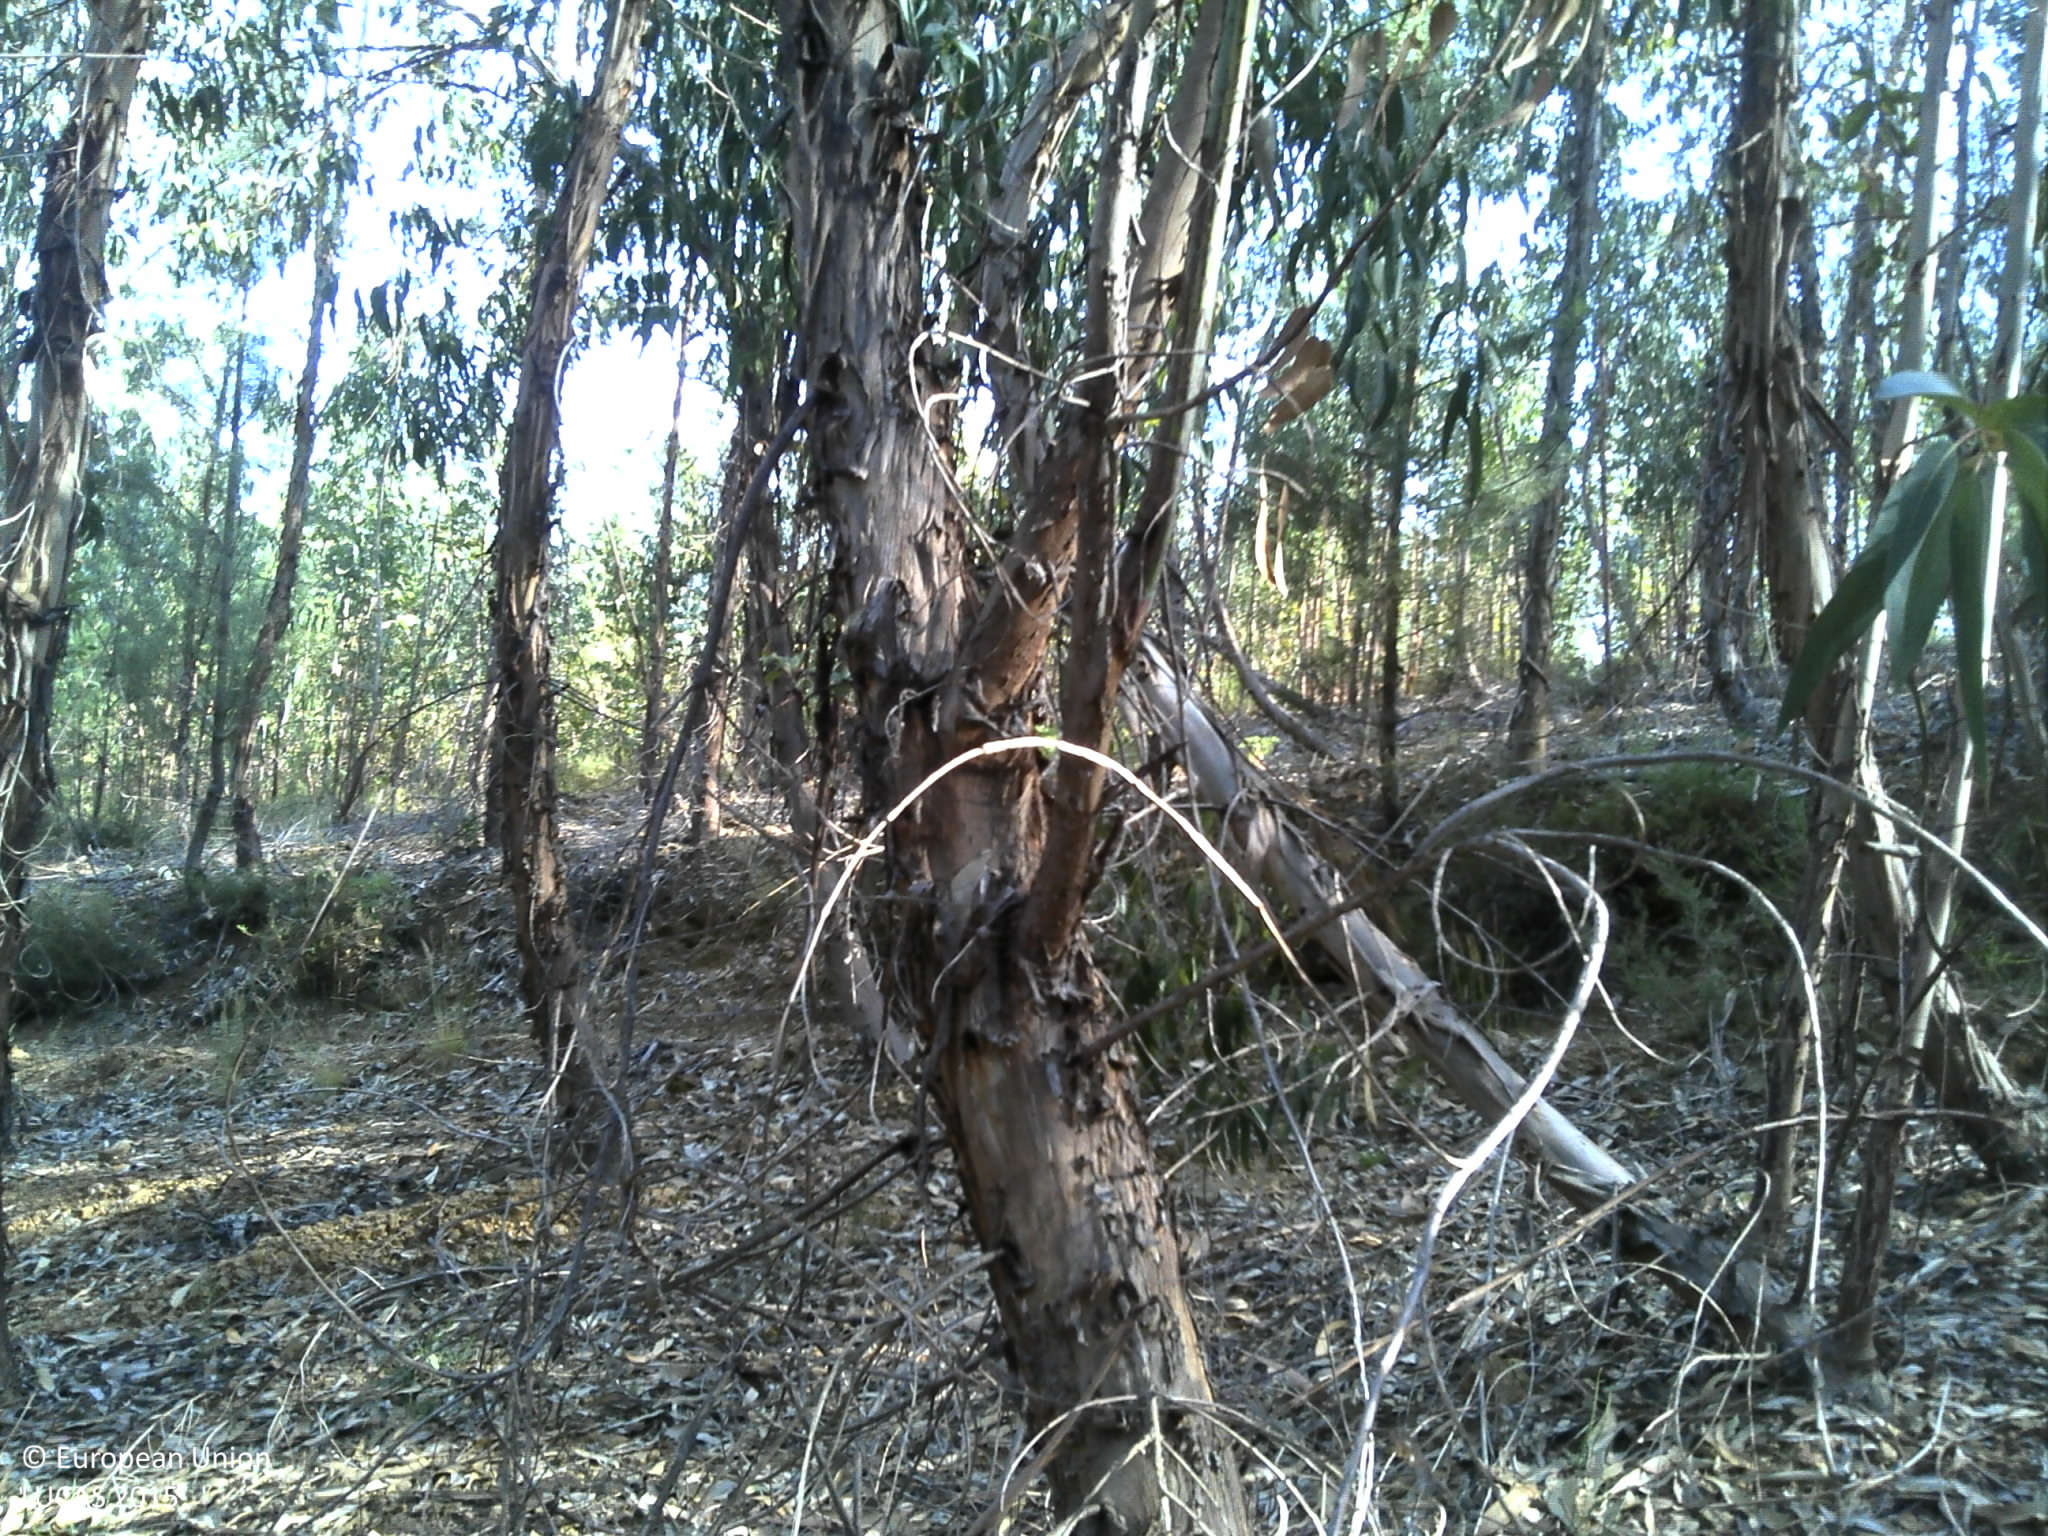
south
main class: Woodland
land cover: Broadleaved woodland
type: exotic forest
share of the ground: 25 - 50 %
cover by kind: unconsolidated bare surface 65 %, broadleaved forest trees 30 %, shrubs 5 %
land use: Forestry
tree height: > 5 m
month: June
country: PT
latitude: 39.9835
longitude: -8.1409
